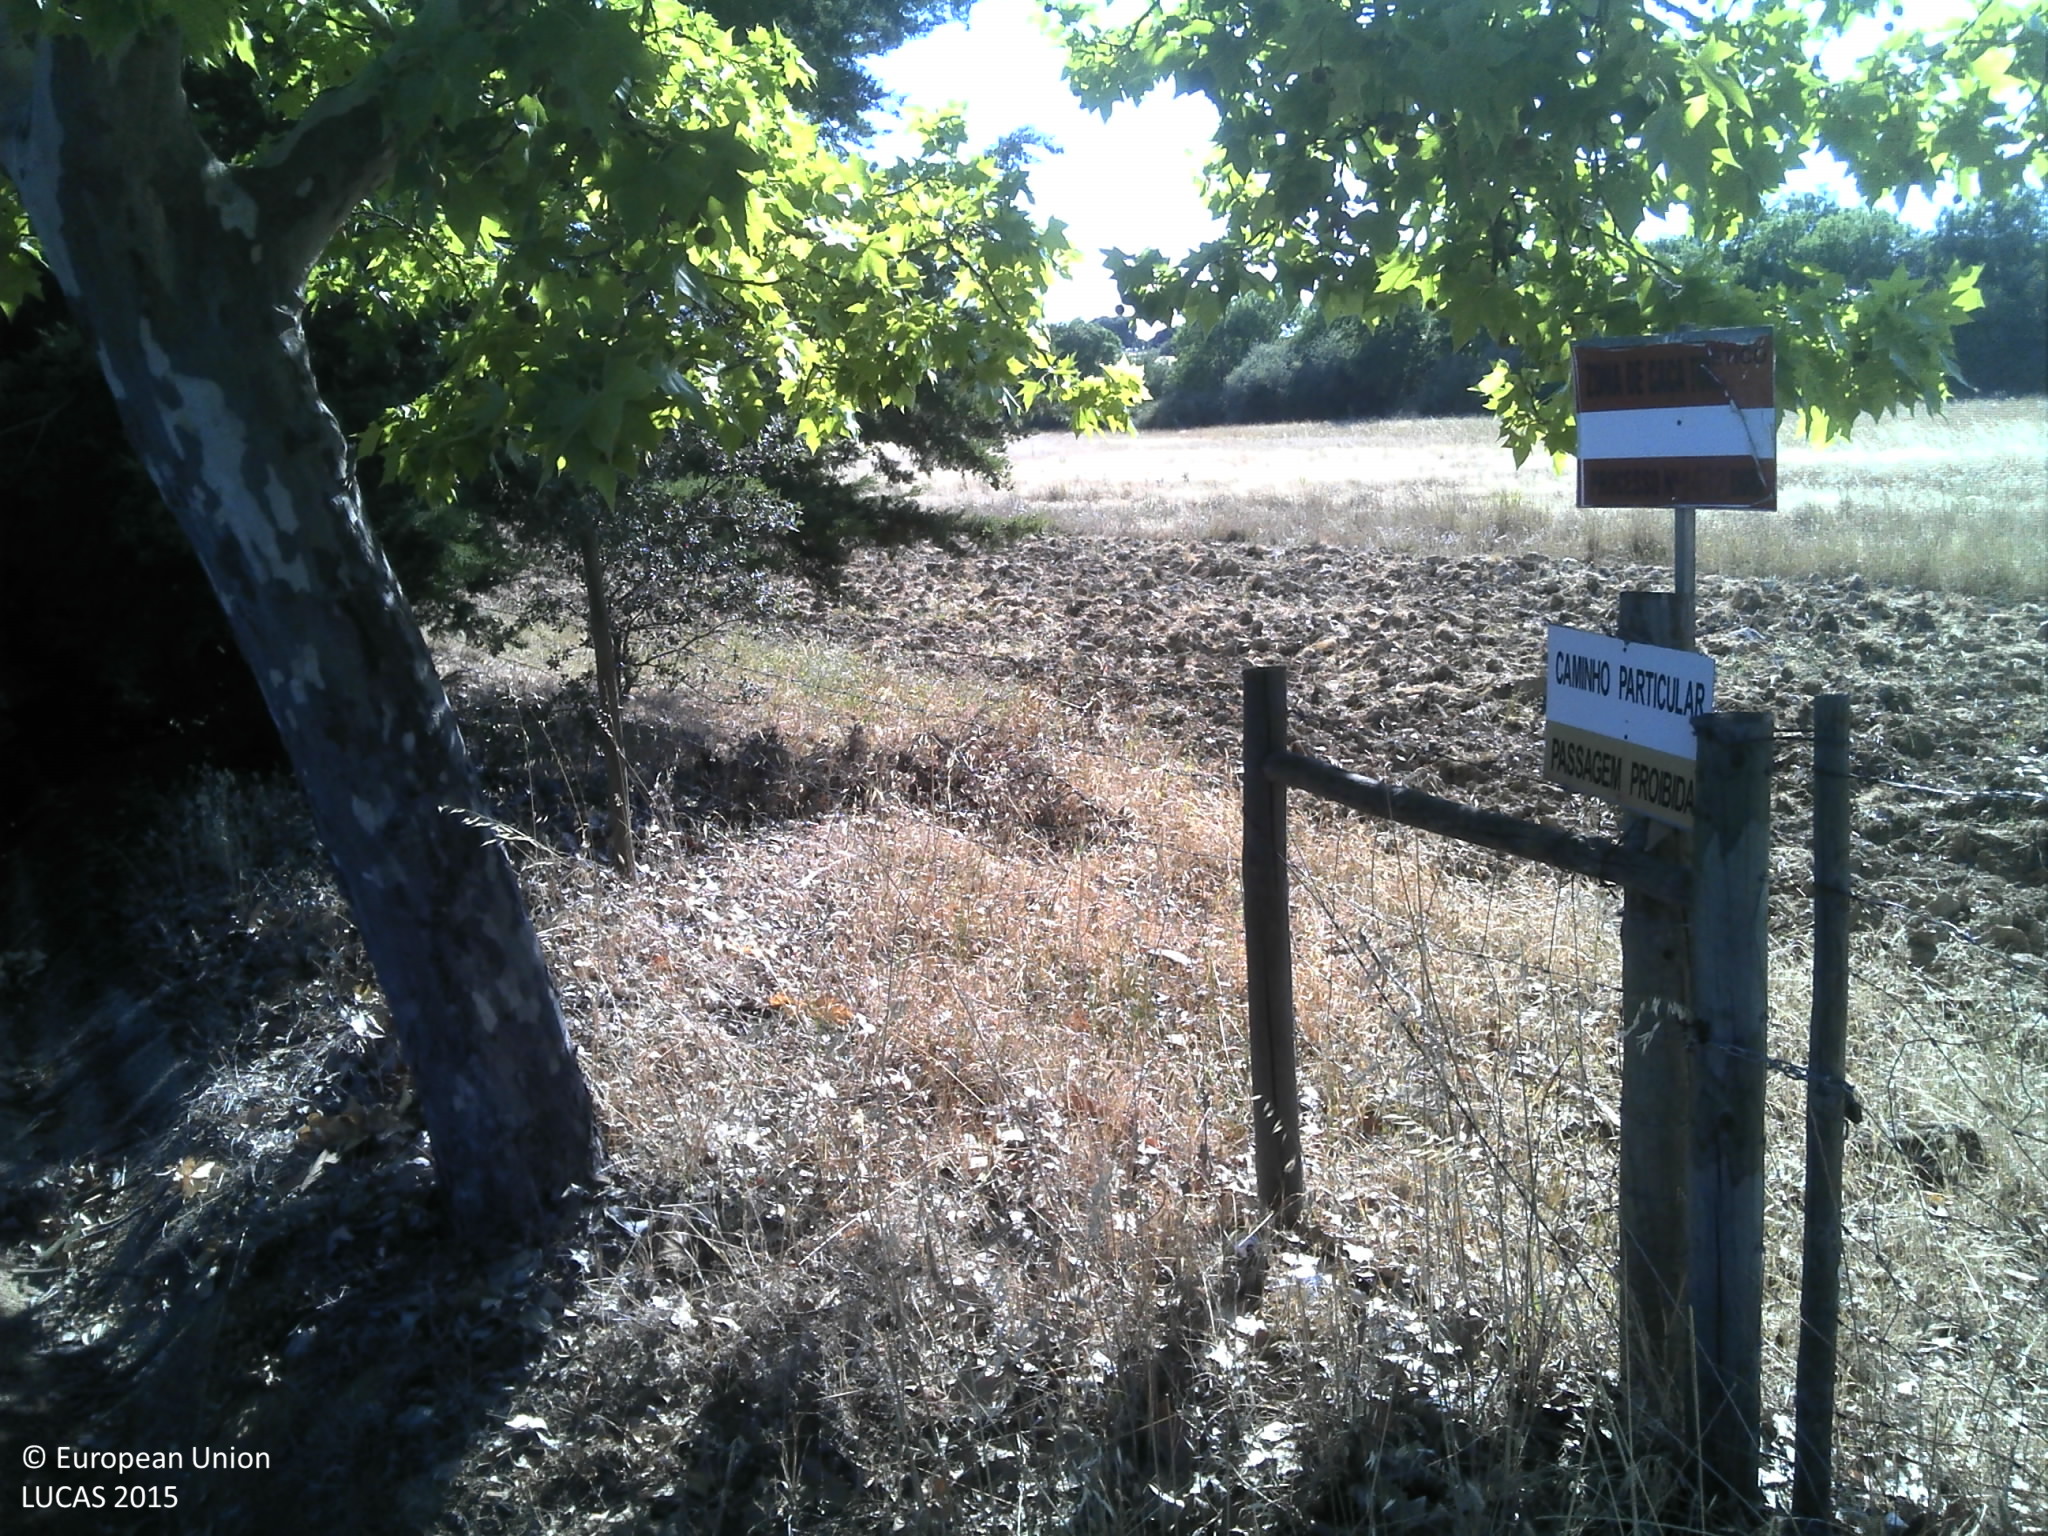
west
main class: Grassland
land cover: Grassland without tree/shrub cover
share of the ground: 50 - 75 %
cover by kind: herbaceous plants 70 %, unconsolidated bare surface 20 %
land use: Agriculture (excluding fallow land and kitchen gardens)
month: June
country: PT
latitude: 39.9442
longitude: -7.1452
